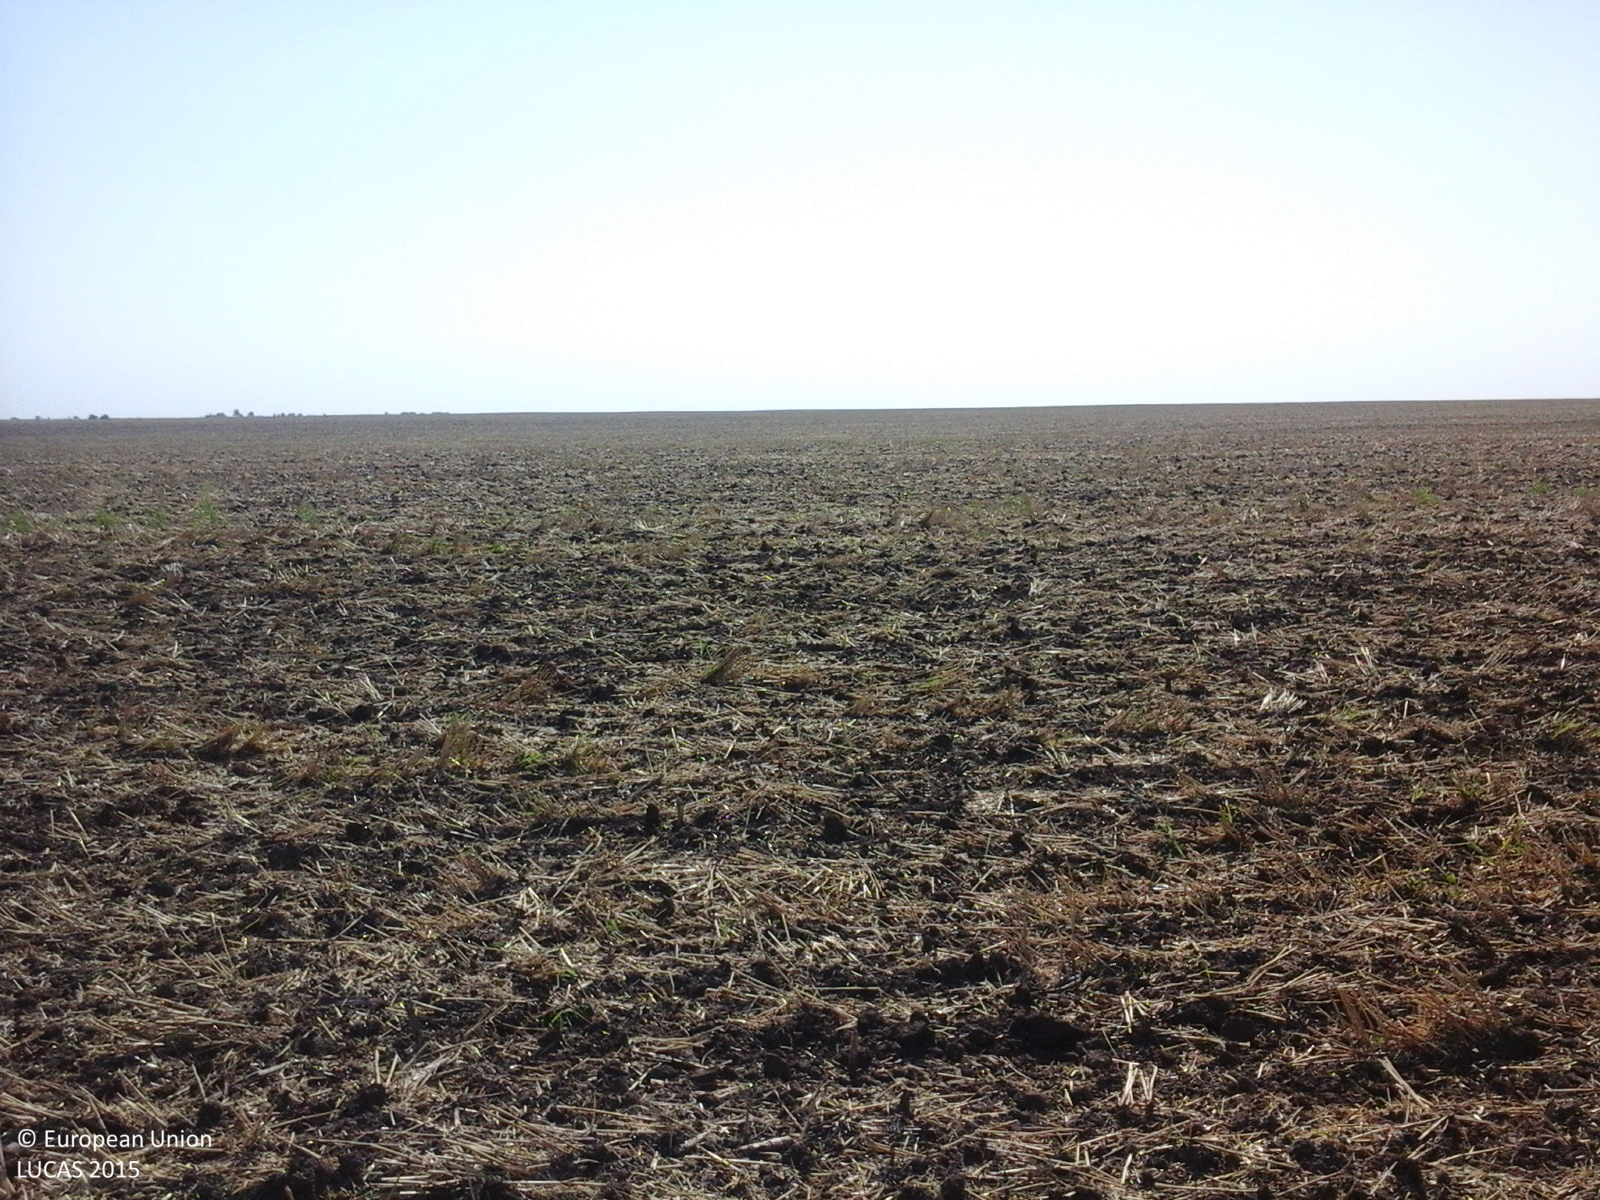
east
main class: Cropland
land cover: Common wheat
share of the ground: 10 - 25 %
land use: Agriculture (excluding fallow land and kitchen gardens)
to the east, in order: Common wheat
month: July
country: RO
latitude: 44.3126
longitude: 27.4529
